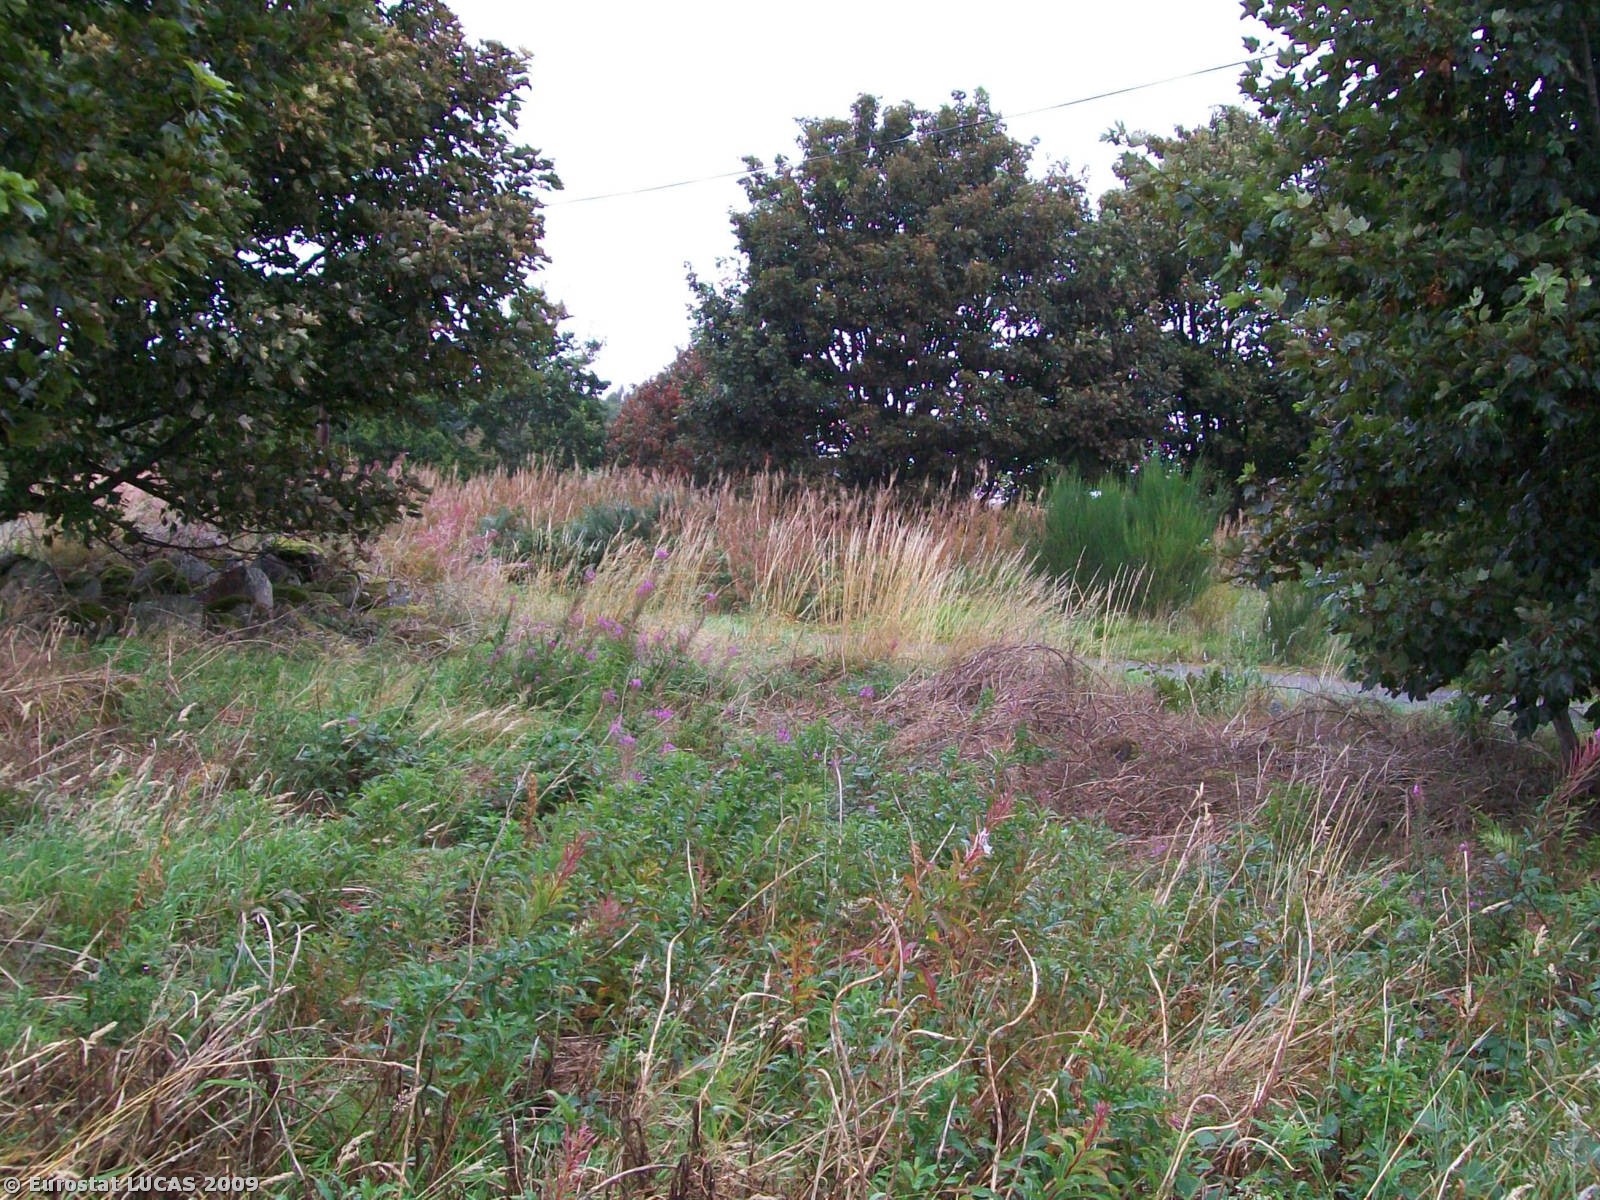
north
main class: Grassland
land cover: Grassland with sparse tree/shrub cover
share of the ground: > 75 %
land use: Fallow land
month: September
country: GB
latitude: 57.0911
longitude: -2.4476
